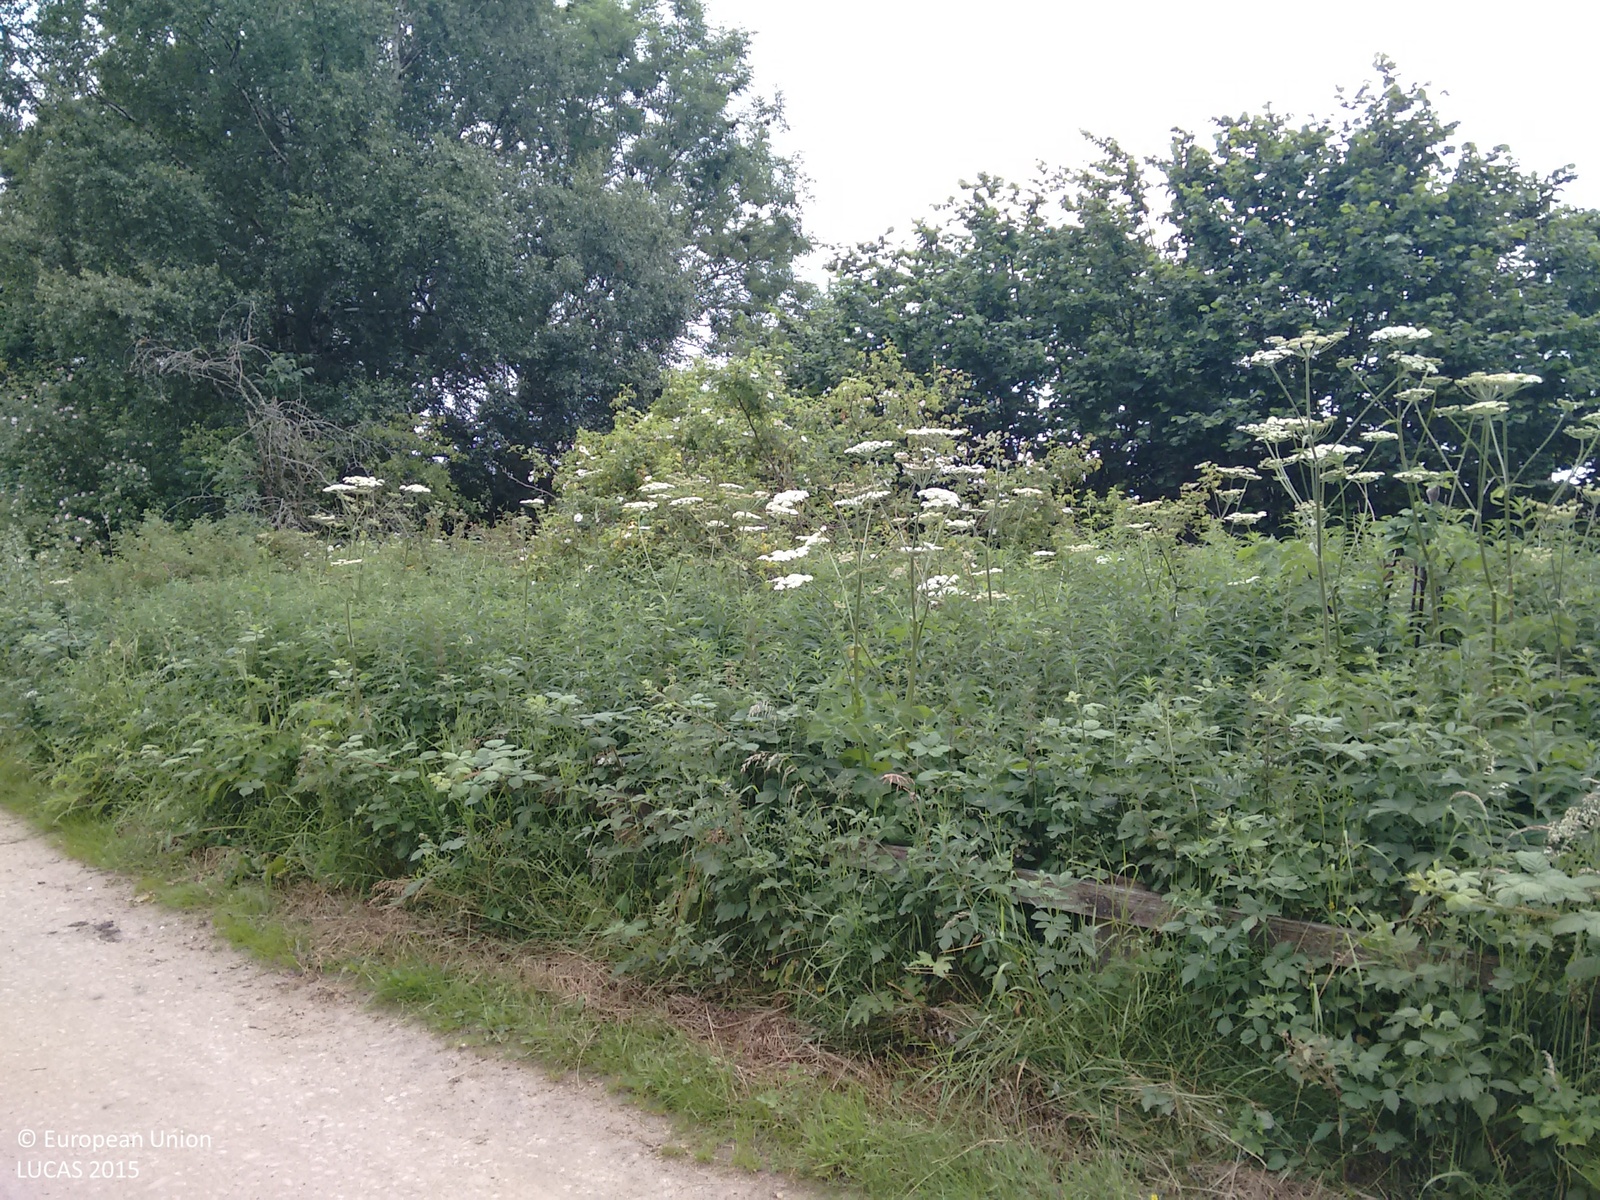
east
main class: Grassland
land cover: Grassland without tree/shrub cover
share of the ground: > 75 %
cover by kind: herbaceous plants 100 %
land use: Agriculture (excluding fallow land and kitchen gardens)
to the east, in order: Grassland without tree/shrub cover; Fences; Grassland without tree/shrub cover; Abandoned hedges; Tracks; Fences; Abandoned hedges; Tracks; Abandoned hedges; Fences; Abandoned hedges; Tracks; Abandoned hedges; Fences; Grassland without tree/shrub cover; Fences; Grassland without tree/shrub cover; Fences; Grassland without tree/shrub cover; Artificial constructions in urban areas; Single bushes/trees; Grassland without tree/shrub cover; Artificial constructions in urban areas; Managed hedges; Electric lines; Paved roads, cycling and walking lanes; Managed hedges; Fences; Managed hedges; Broadleaved woodland
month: July
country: GB
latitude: 53.3393
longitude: -2.0890
